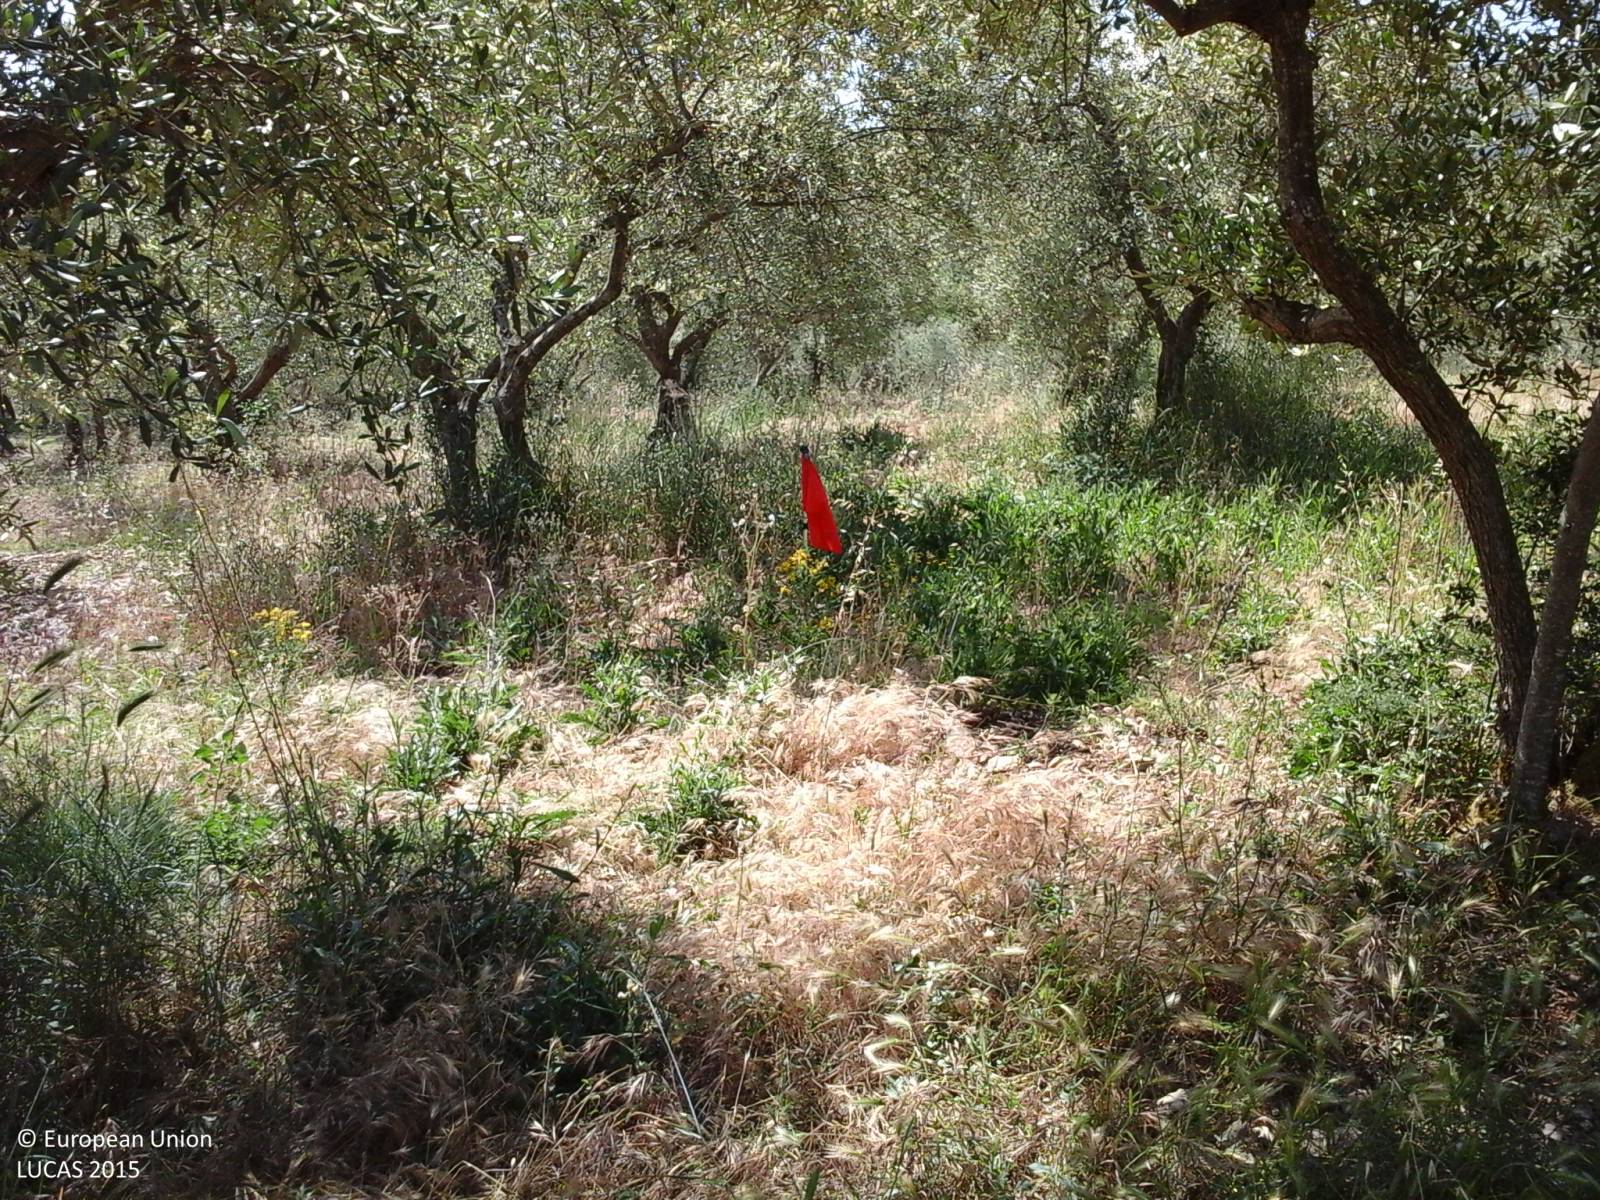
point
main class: Cropland
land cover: Olive groves
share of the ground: 25 - 50 %
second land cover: Spontaneously vegetated surfaces
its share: 50 - 75 %
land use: Abandoned areas
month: June
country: IT
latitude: 42.0757
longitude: 13.8189
